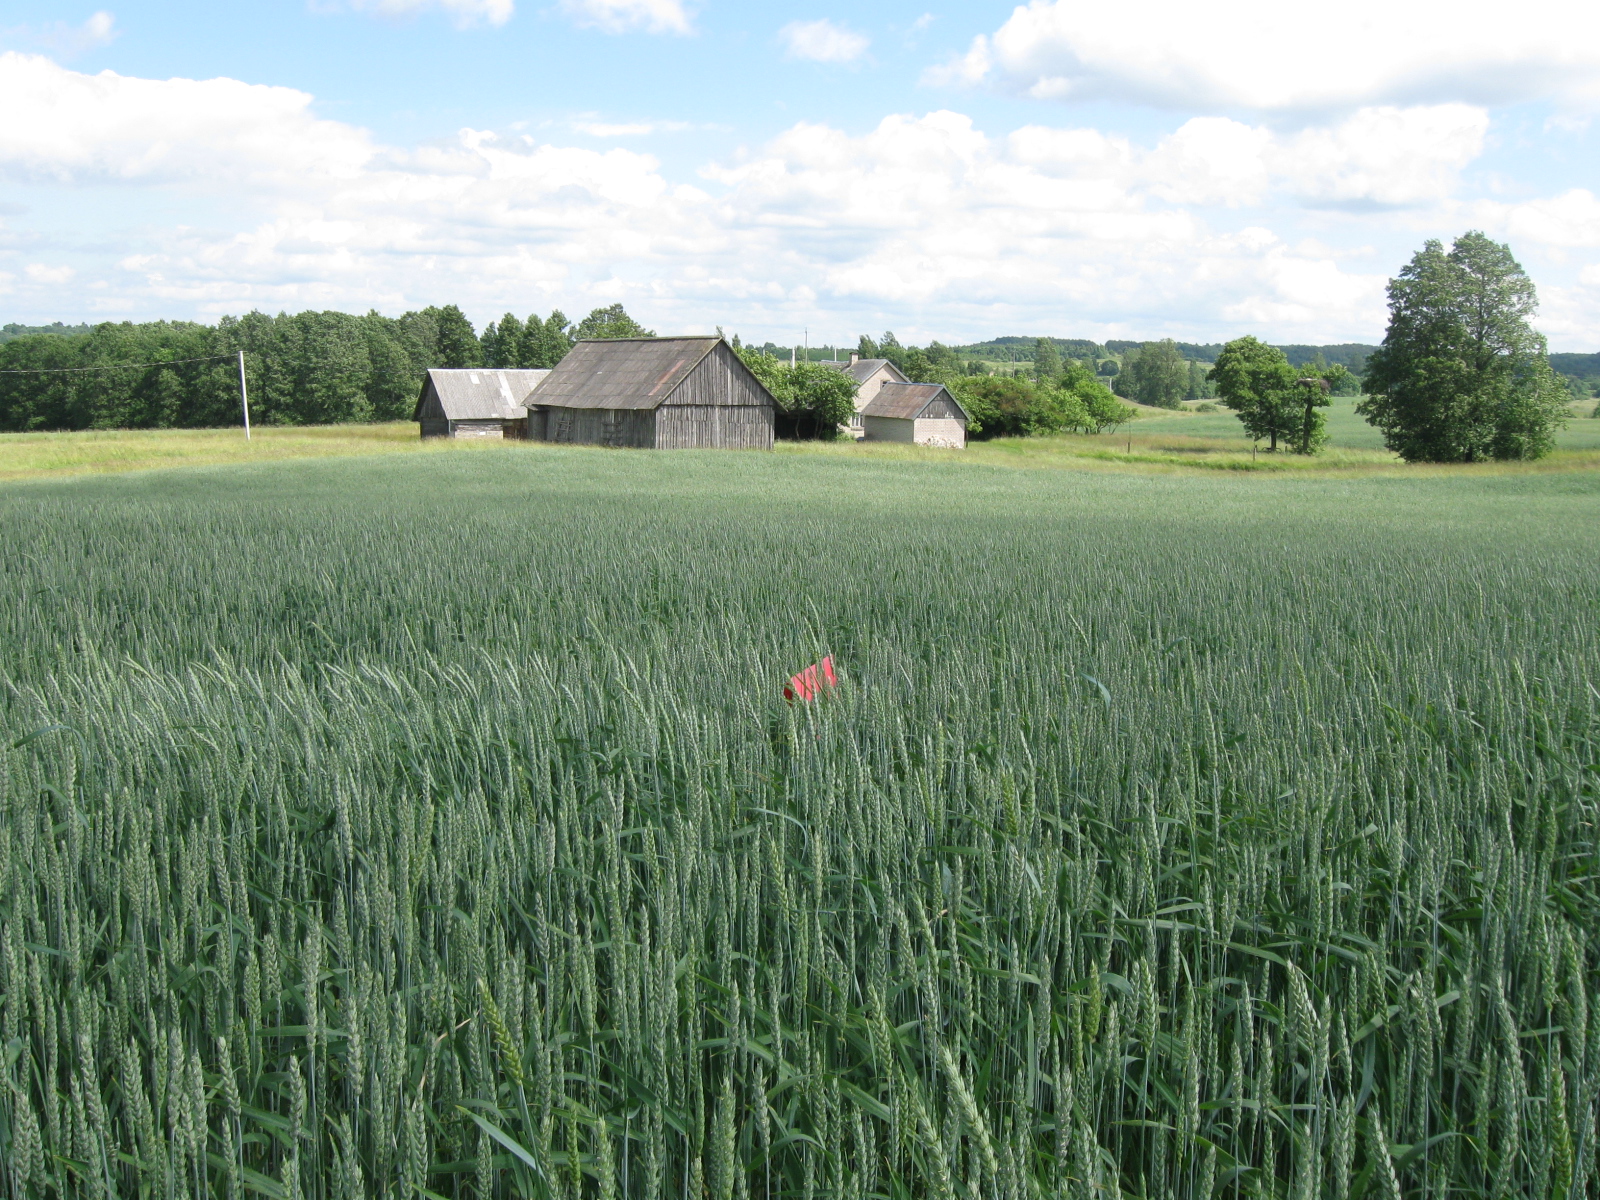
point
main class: Cropland
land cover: Common wheat
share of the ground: > 75 %
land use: Agriculture (excluding fallow land and kitchen gardens)
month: June
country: LT
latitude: 54.6516
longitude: 24.4377
